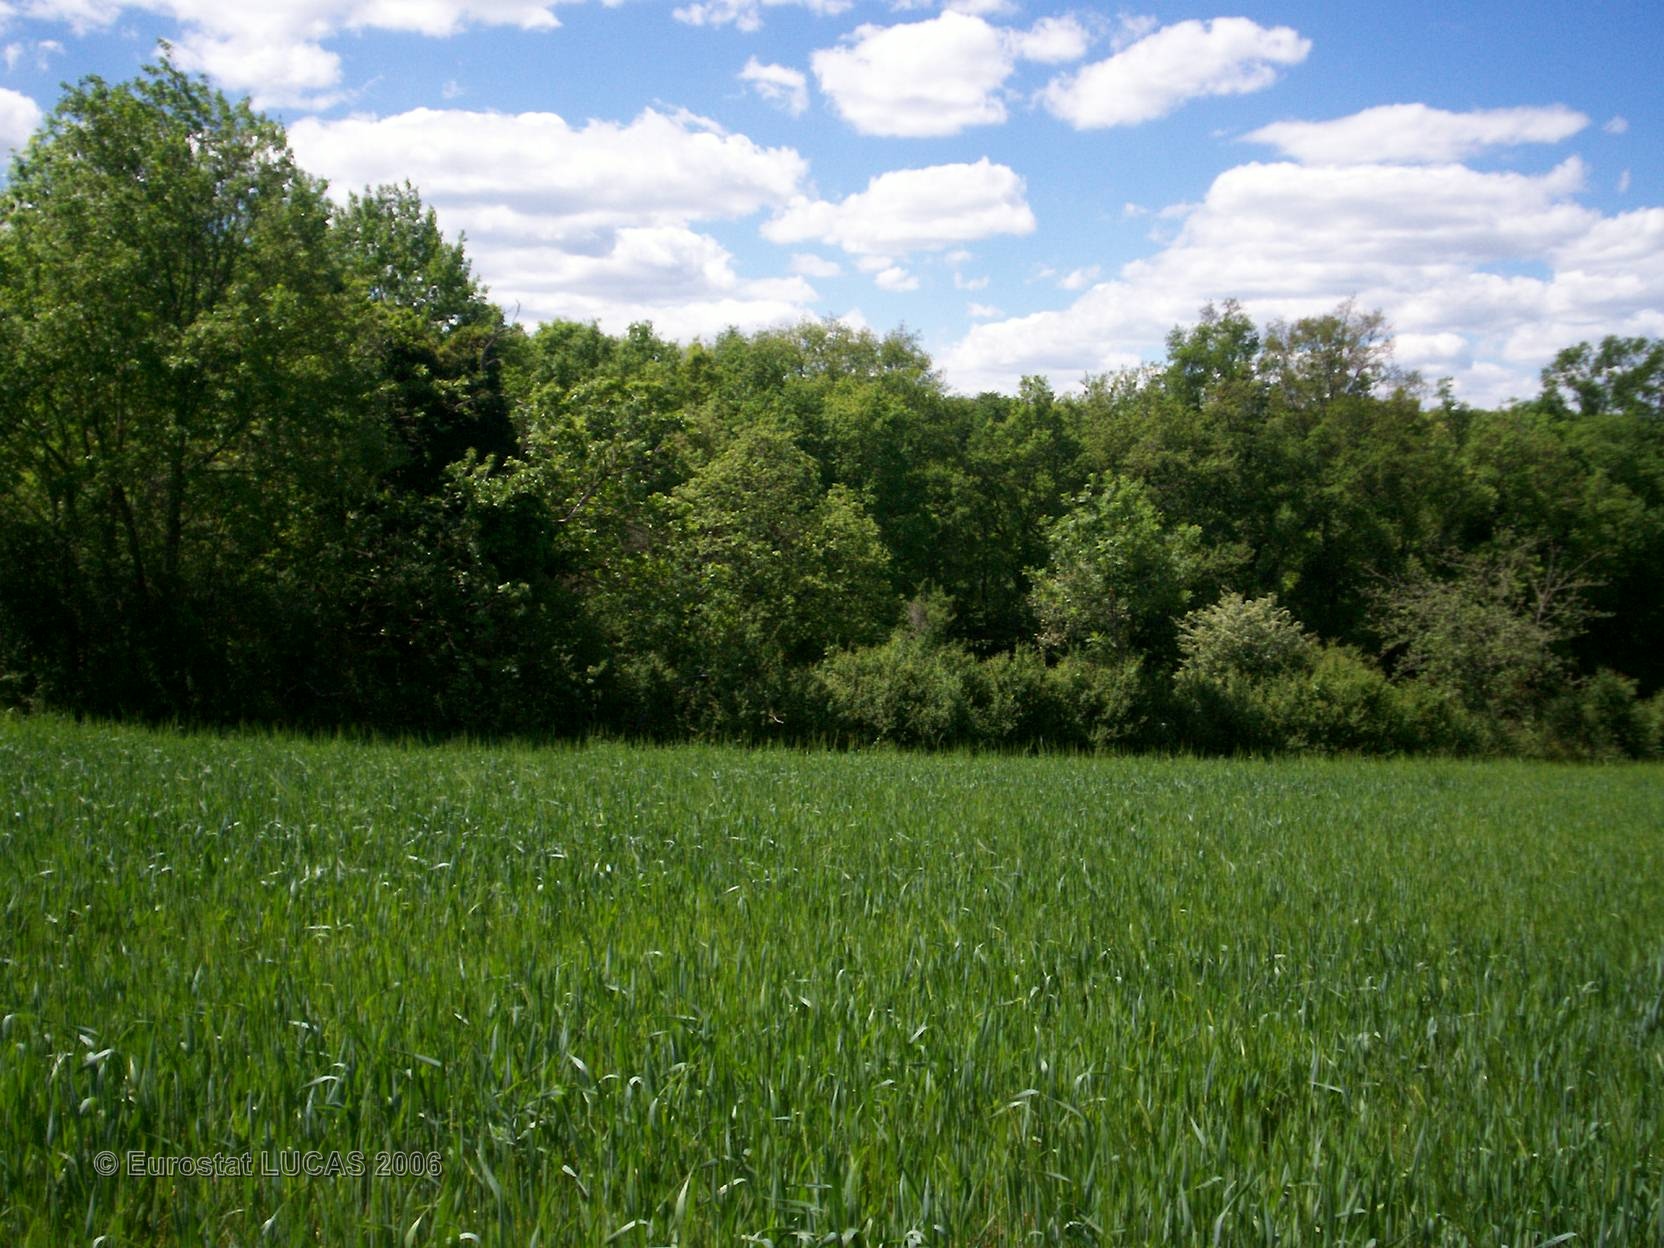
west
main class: Cropland
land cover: Barley
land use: Agriculture (excluding fallow land and kitchen gardens)
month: May
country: FR
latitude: 44.1651
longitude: 1.9609
